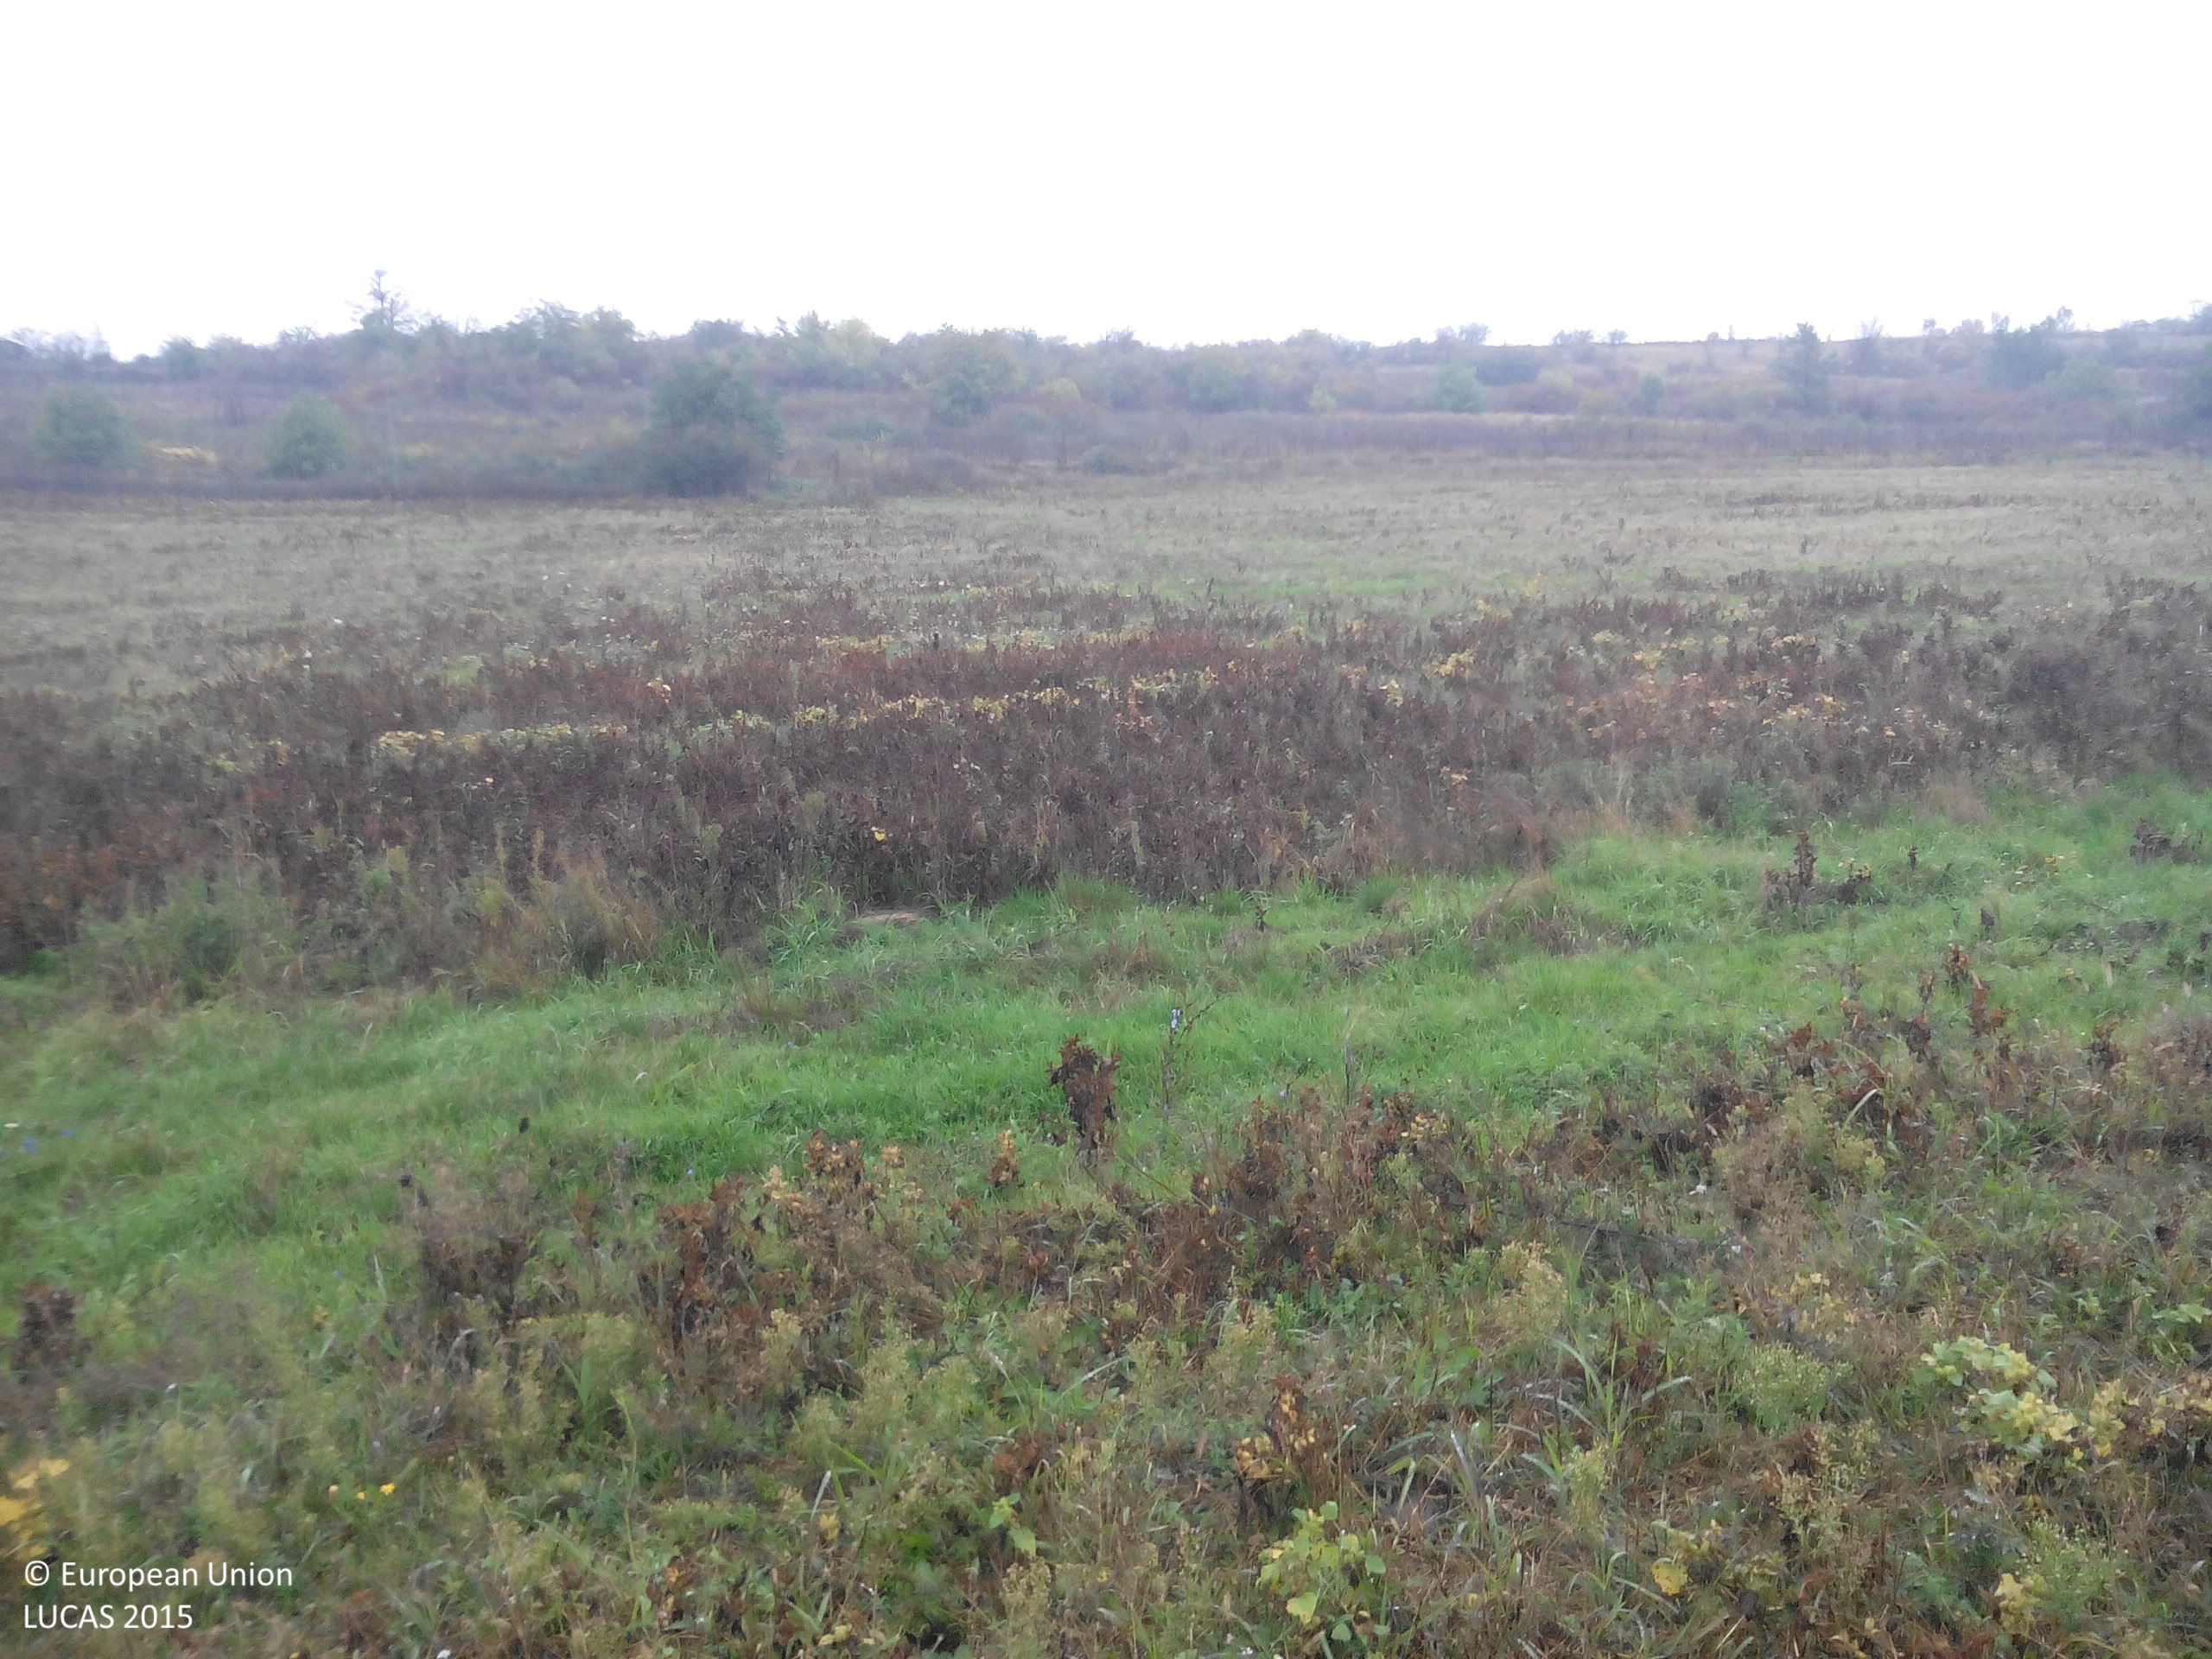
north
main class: Grassland
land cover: Grassland without tree/shrub cover
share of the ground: > 75 %
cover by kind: herbaceous plants 95 %, shrubs 5 %
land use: Agriculture (excluding fallow land and kitchen gardens)
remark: Harvested field
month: October
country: BG
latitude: 43.1724
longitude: 24.1617
